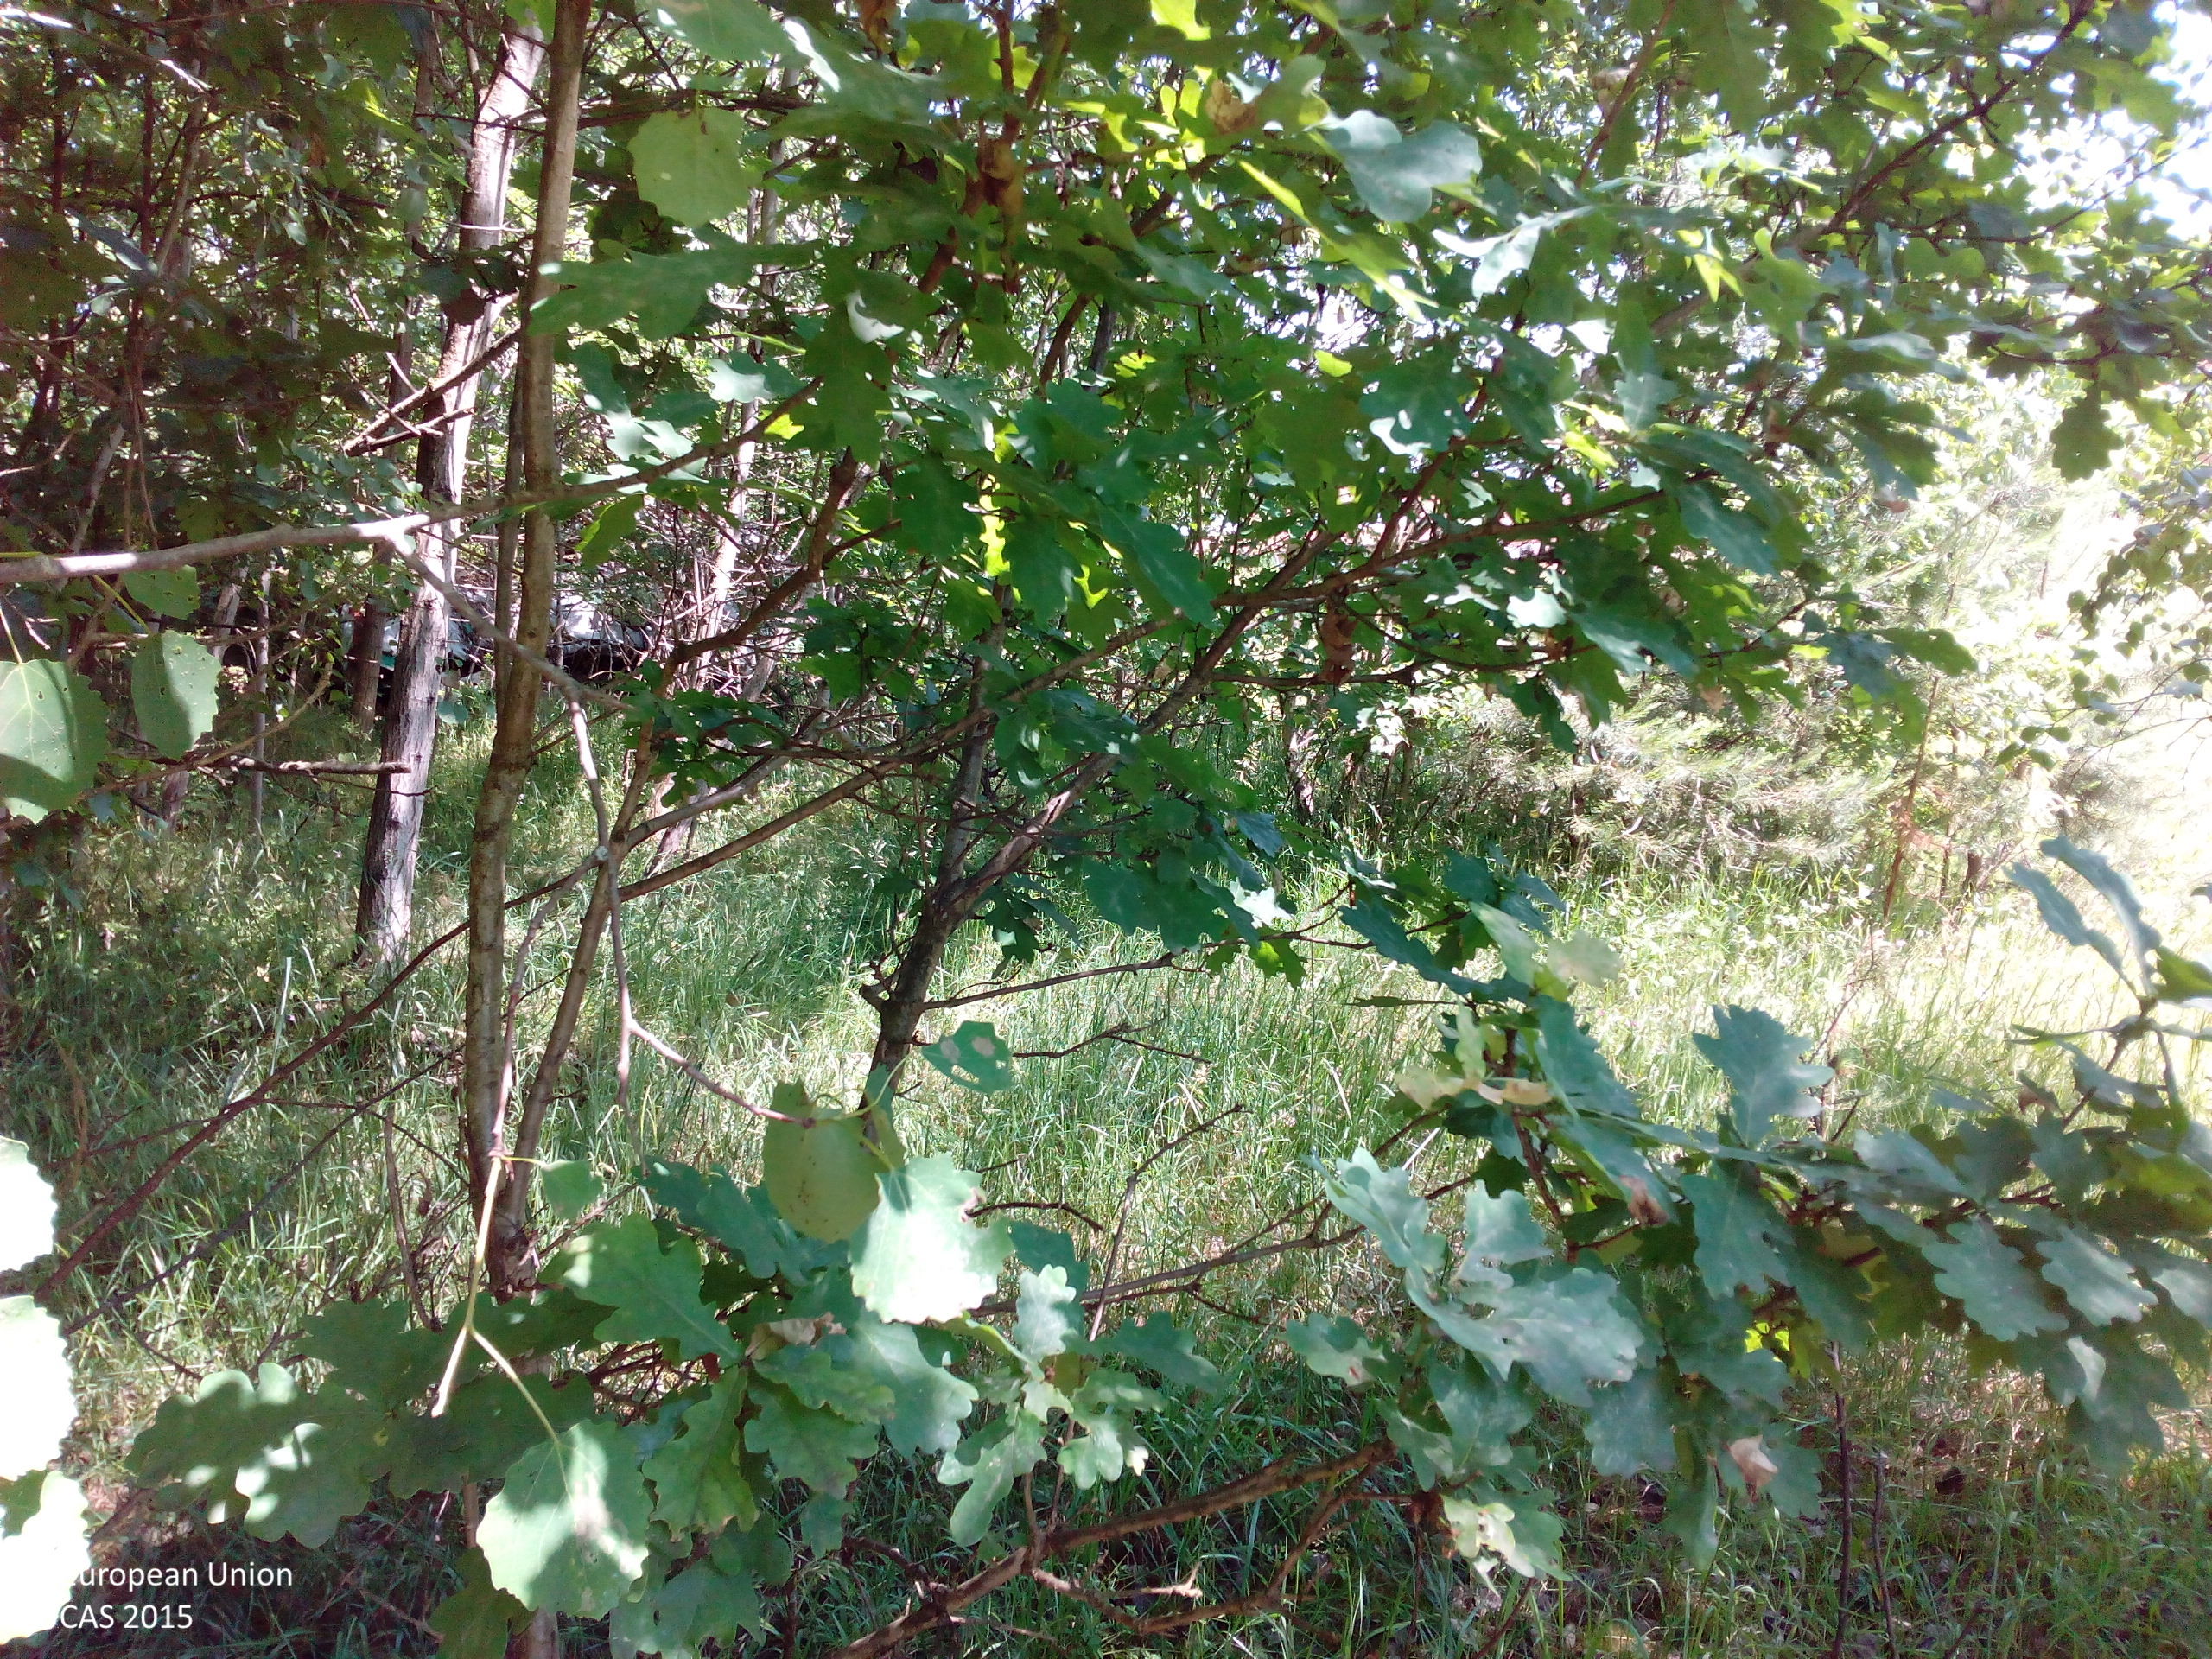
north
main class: Woodland
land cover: Broadleaved woodland
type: mesophytic deciduous forest
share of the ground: > 75 %
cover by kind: broadleaved forest trees 45 %, herbaceous plants 10 %, coniferous forest trees 5 %, lichens and mosses 5 %, unconsolidated bare surface 5 %
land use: Logistics and storage
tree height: > 5 m
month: June
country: DE
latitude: 49.1885
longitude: 12.3457
